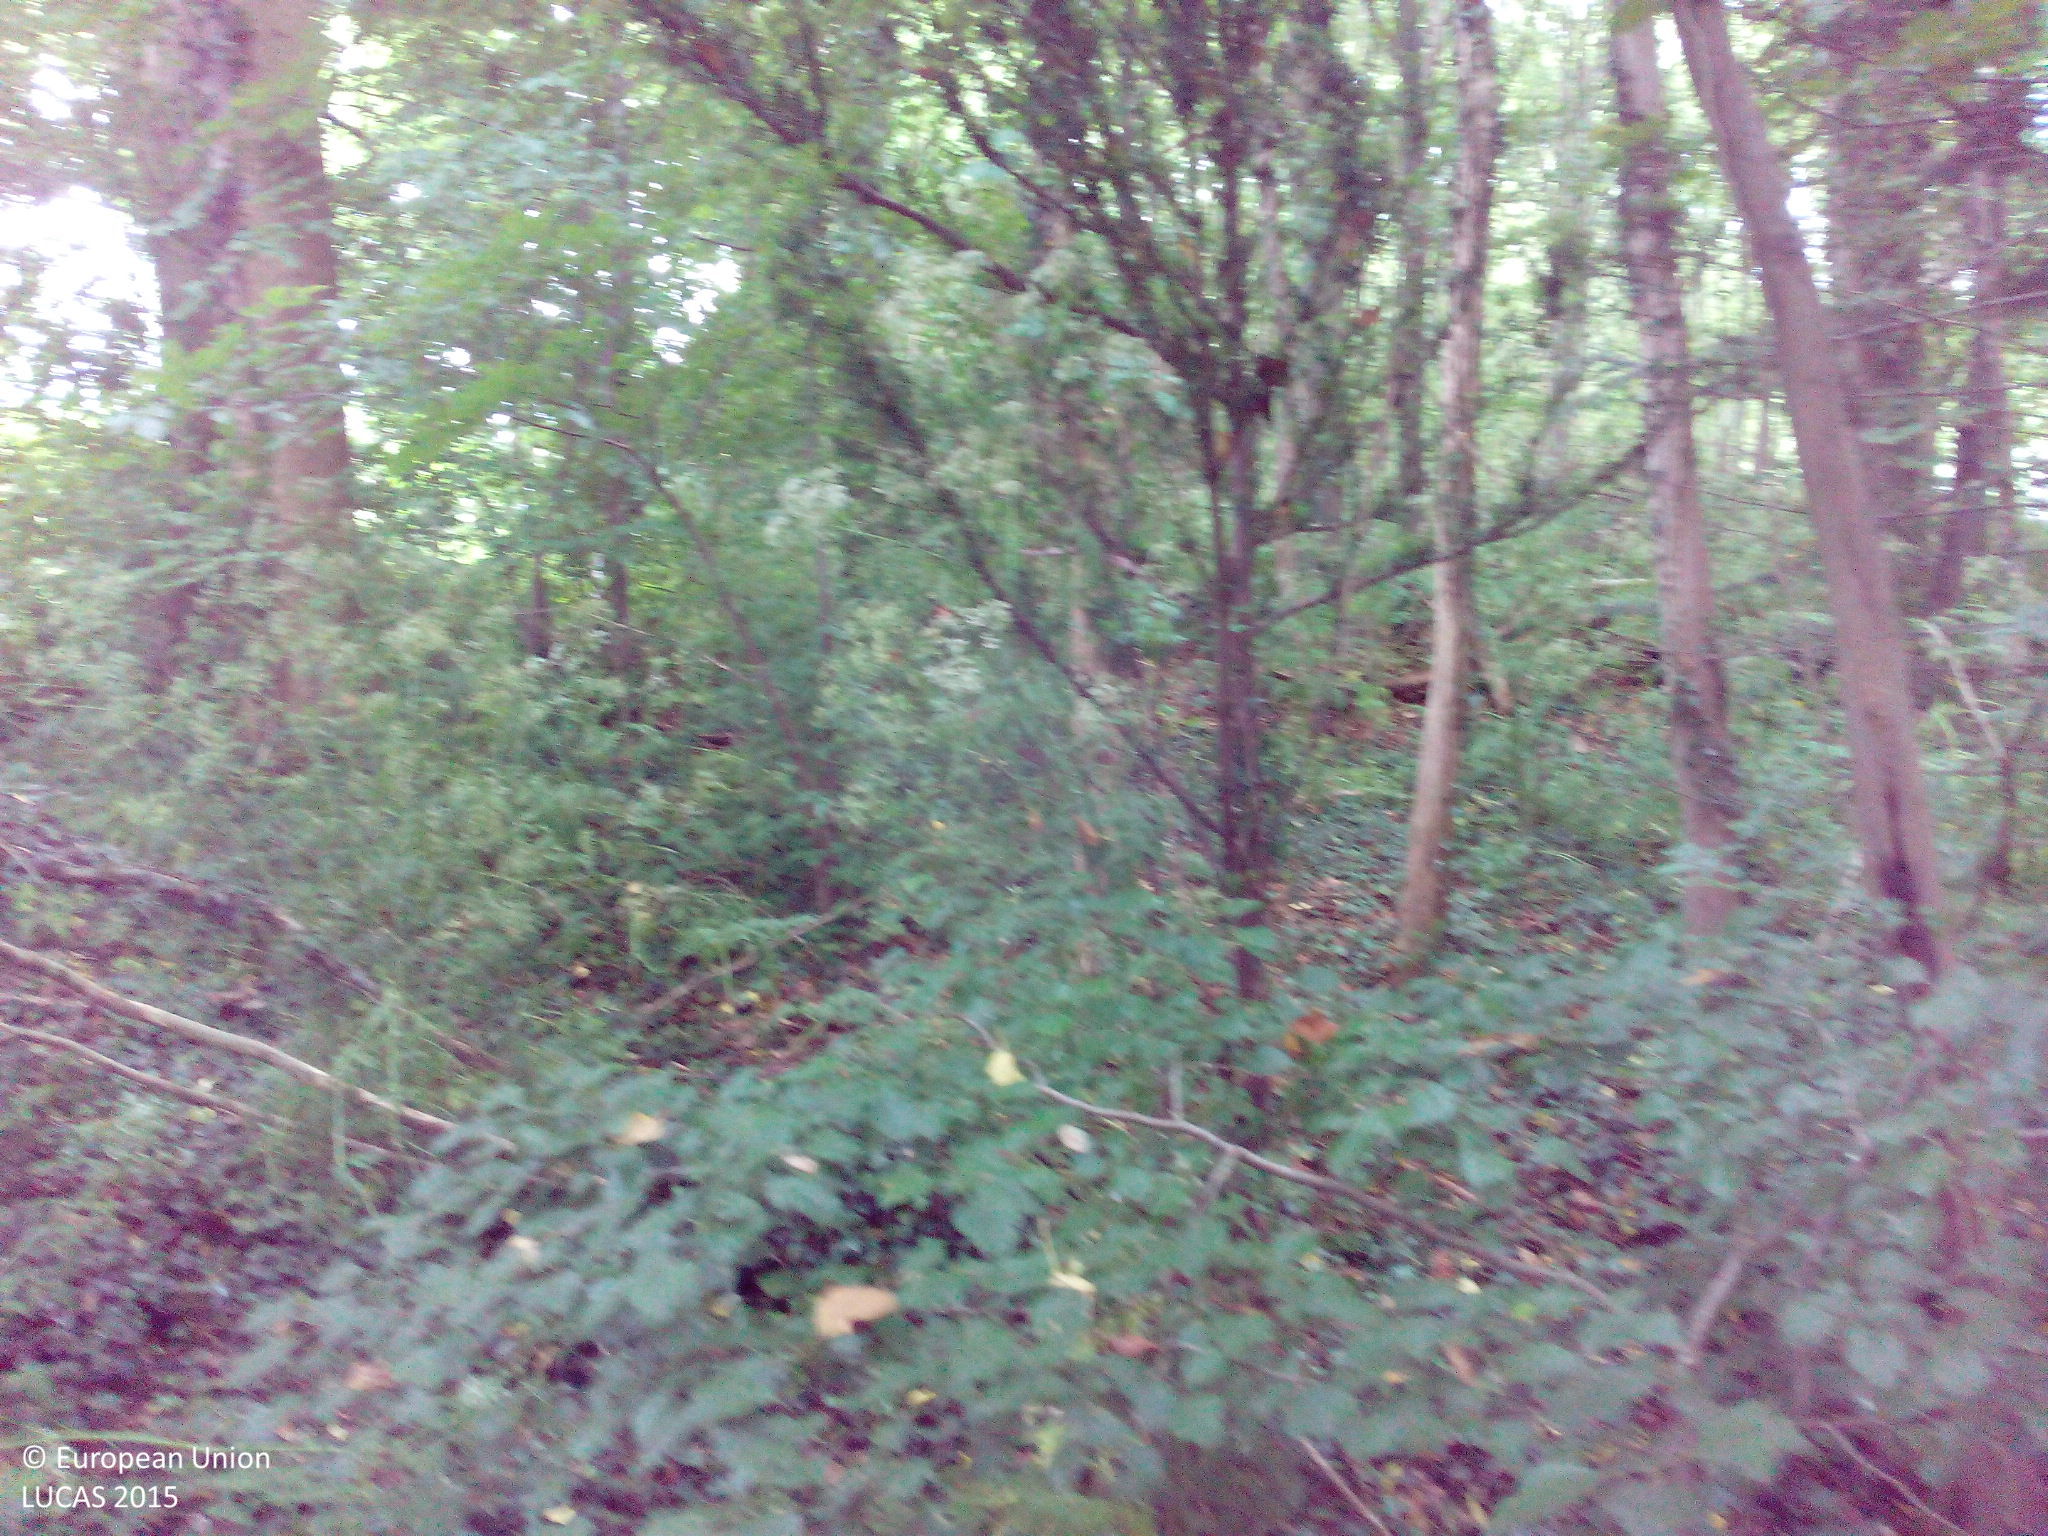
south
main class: Woodland
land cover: Broadleaved woodland
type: beech forest
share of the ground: > 75 %
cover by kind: broadleaved forest trees 100 %
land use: Residential
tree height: > 5 m
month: June
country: DK
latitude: 54.9452
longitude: 10.7644
